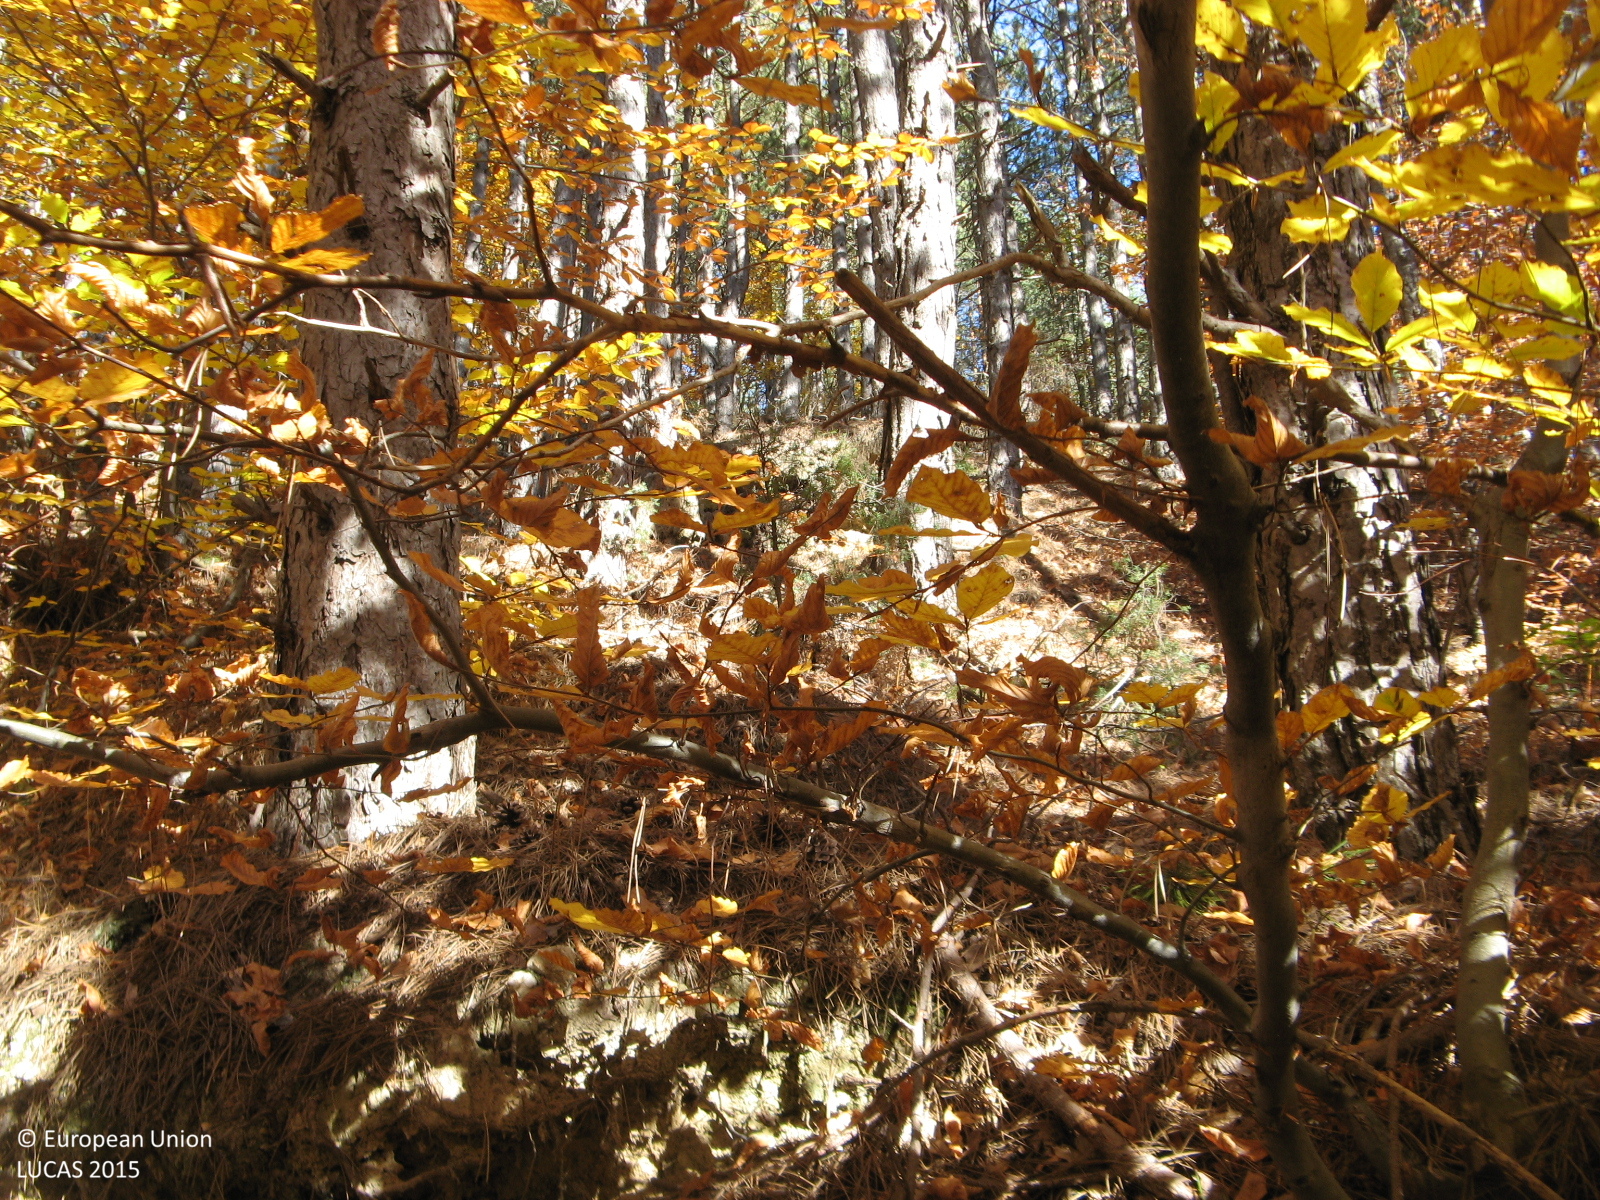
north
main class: Woodland
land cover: Pine dominated mixed woodland
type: hemiboreal forest and nemoral coniferous forest and mixed broadleaved-coniferous forest
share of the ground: > 75 %
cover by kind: coniferous forest trees 75 %, broadleaved forest trees 25 %
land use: Forestry
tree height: > 5 m
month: November
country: BG
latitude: 41.5268
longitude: 25.1394
